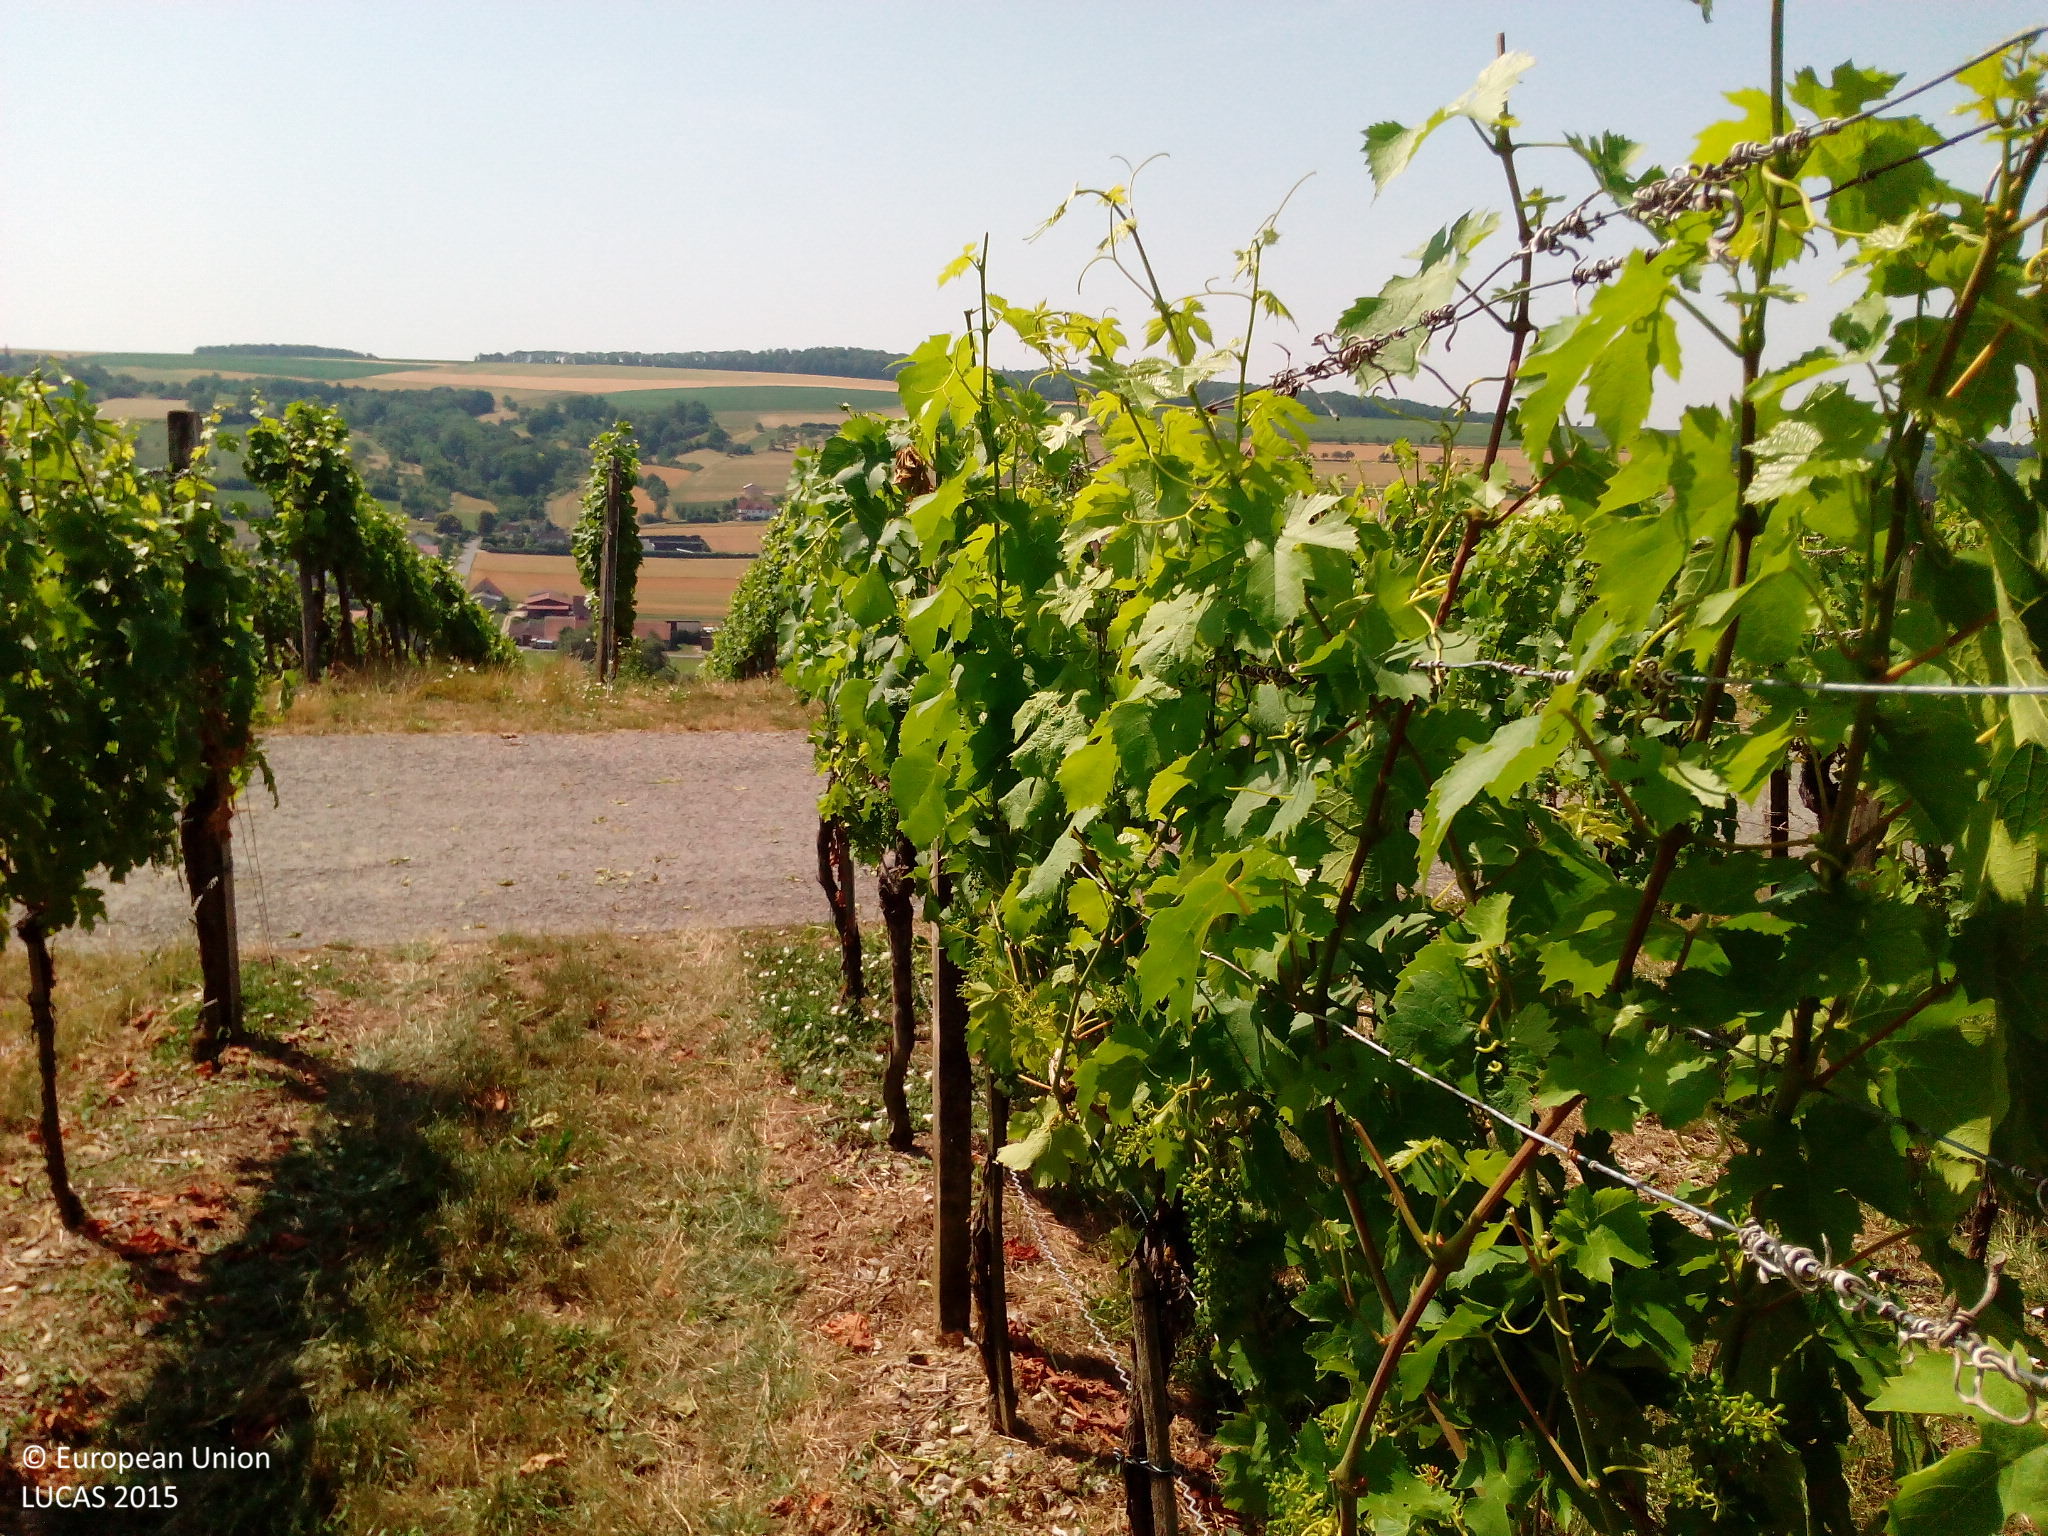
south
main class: Cropland
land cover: Vineyards
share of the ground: 25 - 50 %
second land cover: Spontaneously vegetated surfaces
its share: > 75 %
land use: Agriculture (excluding fallow land and kitchen gardens)
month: July
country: DE
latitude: 49.5008
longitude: 9.9310
